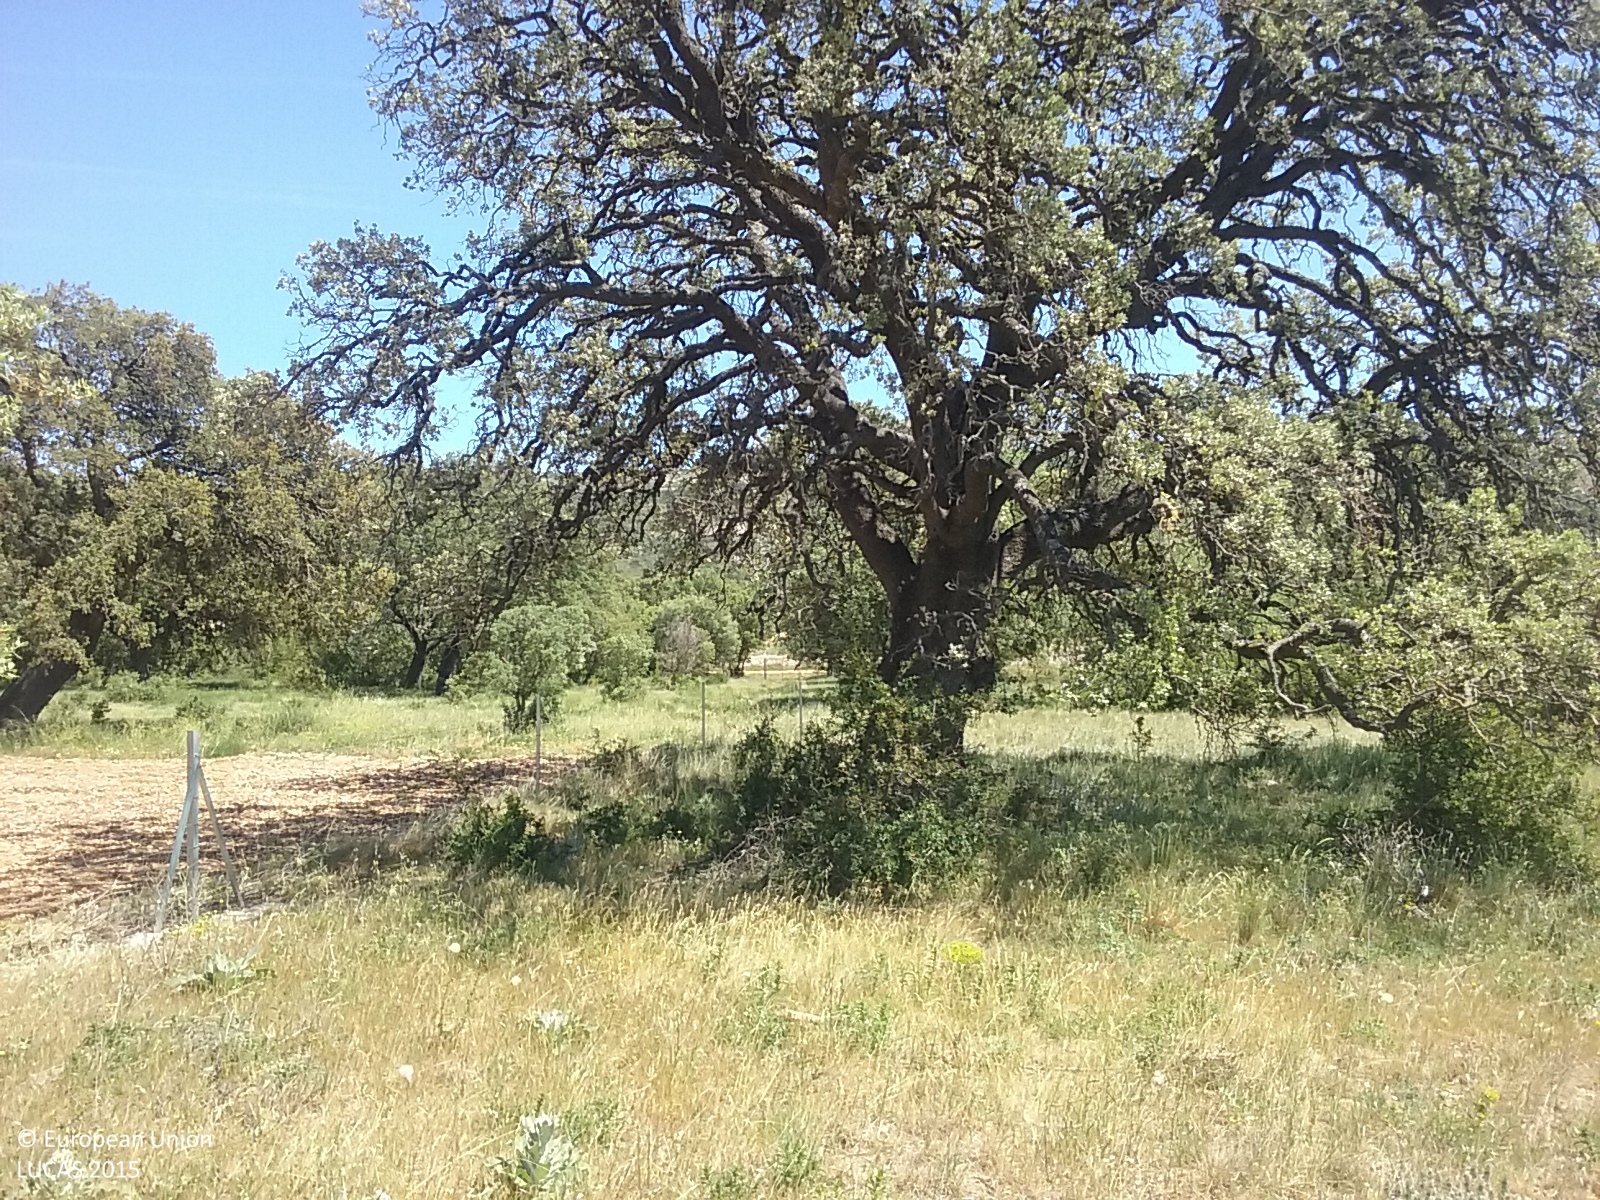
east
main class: Woodland
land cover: Broadleaved woodland
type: broadleaved evergreen forest
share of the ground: 10 - 25 %
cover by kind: herbaceous plants 80 %, broadleaved forest trees 20 %
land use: Forestry
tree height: < 5 m
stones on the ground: 25 - 50 %
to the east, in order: Broadleaved woodland; Fences; Broadleaved woodland; Fences; Shrubland with sparse tree cover; Tracks; Groves; Broadleaved woodland; Fences; Nuts trees; Fences; Common wheat
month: May
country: ES
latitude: 40.4076
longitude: -0.0328
